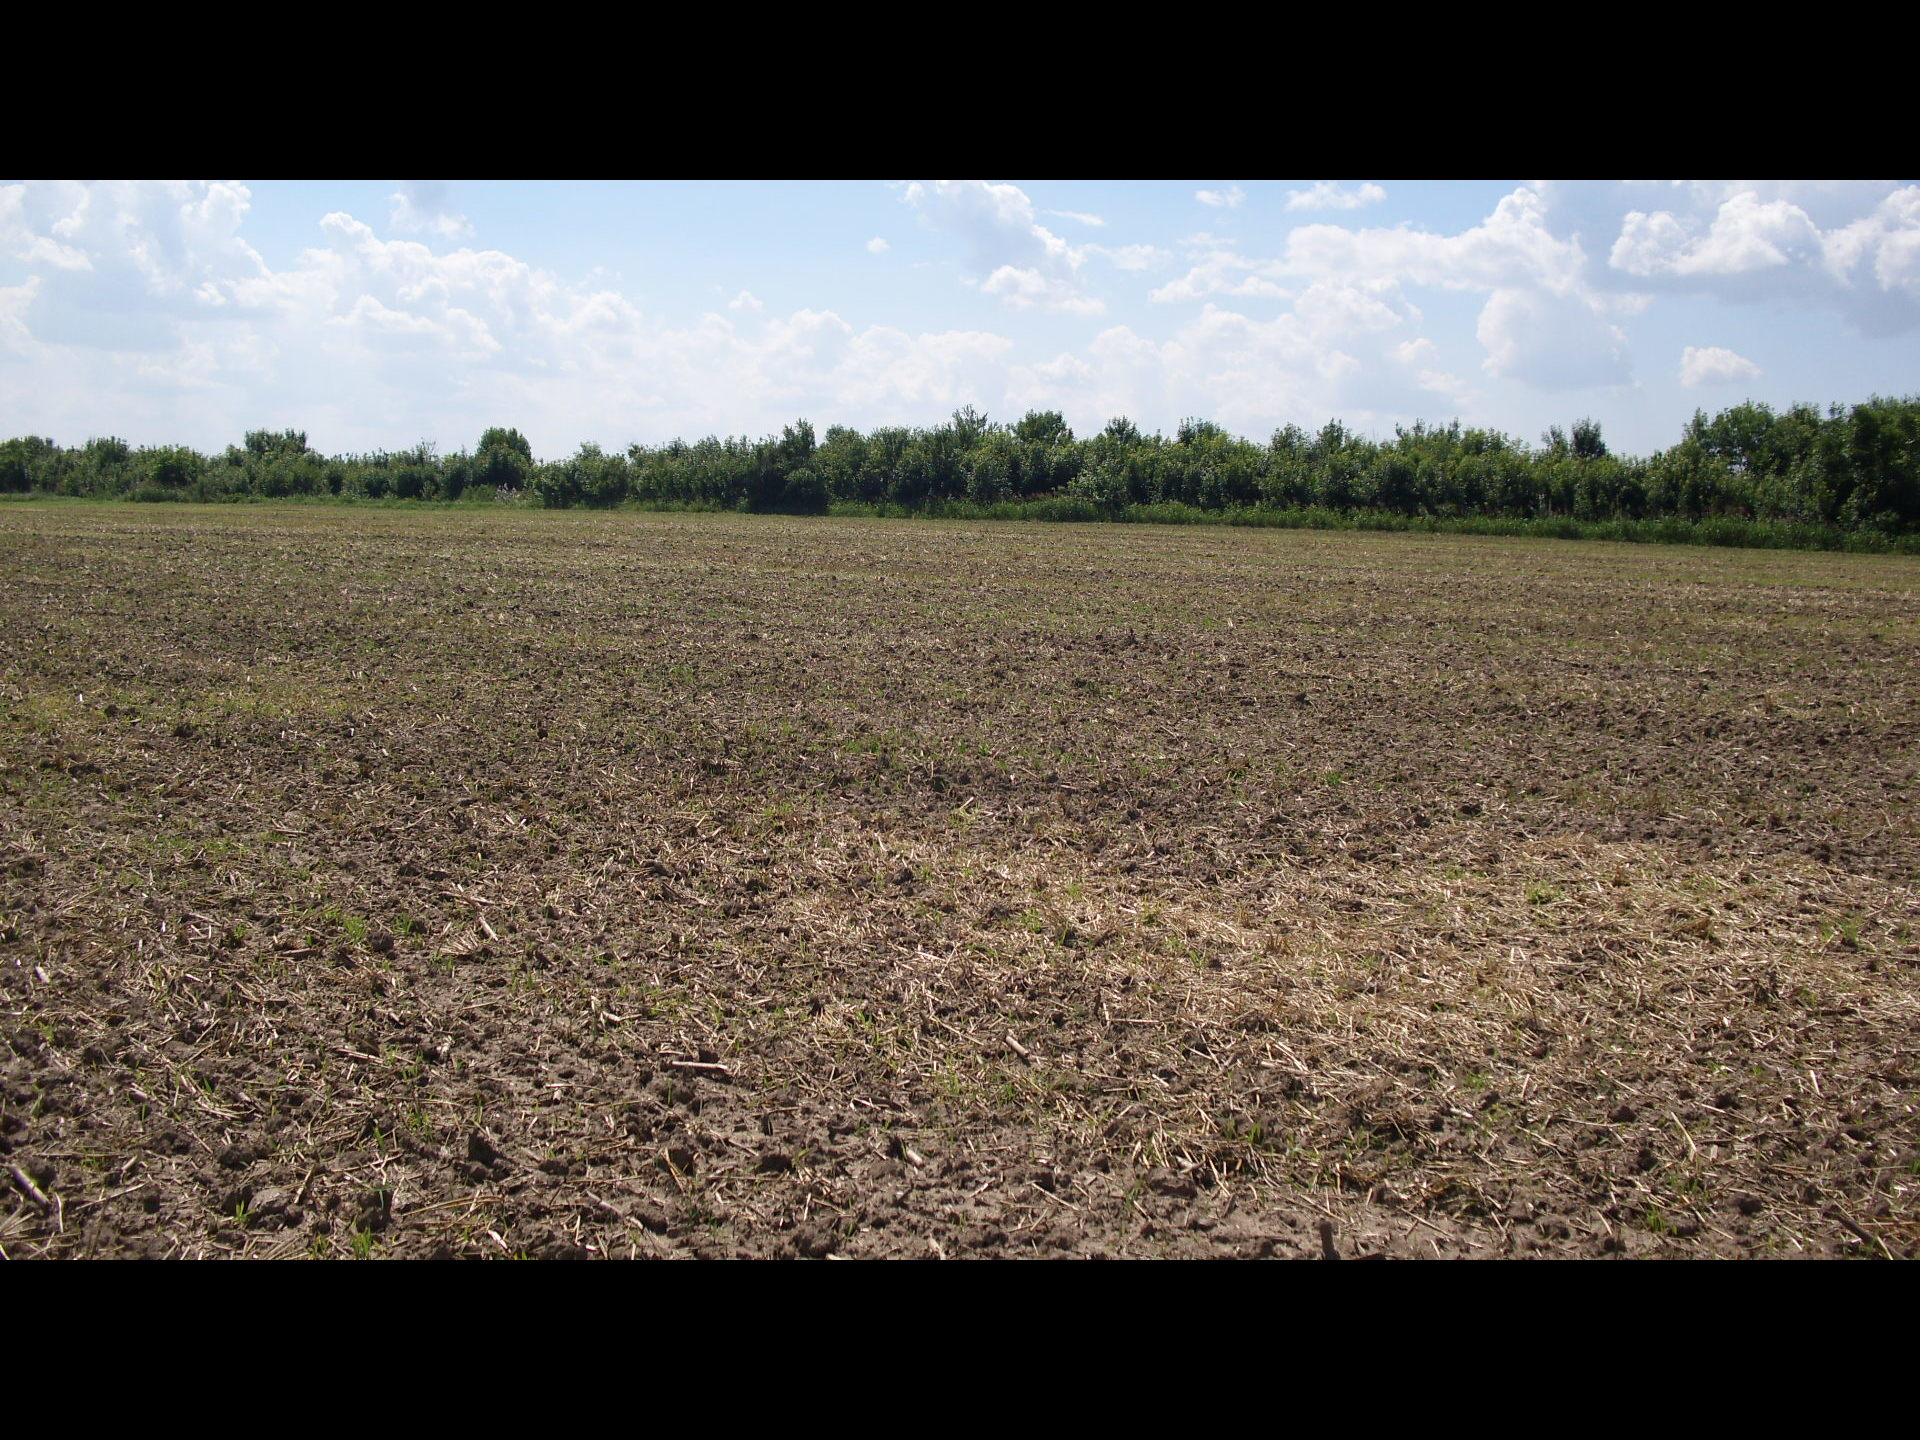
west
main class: Cropland
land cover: Barley
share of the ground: > 75 %
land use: Agriculture (excluding fallow land and kitchen gardens)
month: July
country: BG
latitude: 43.7241
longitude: 23.4651
